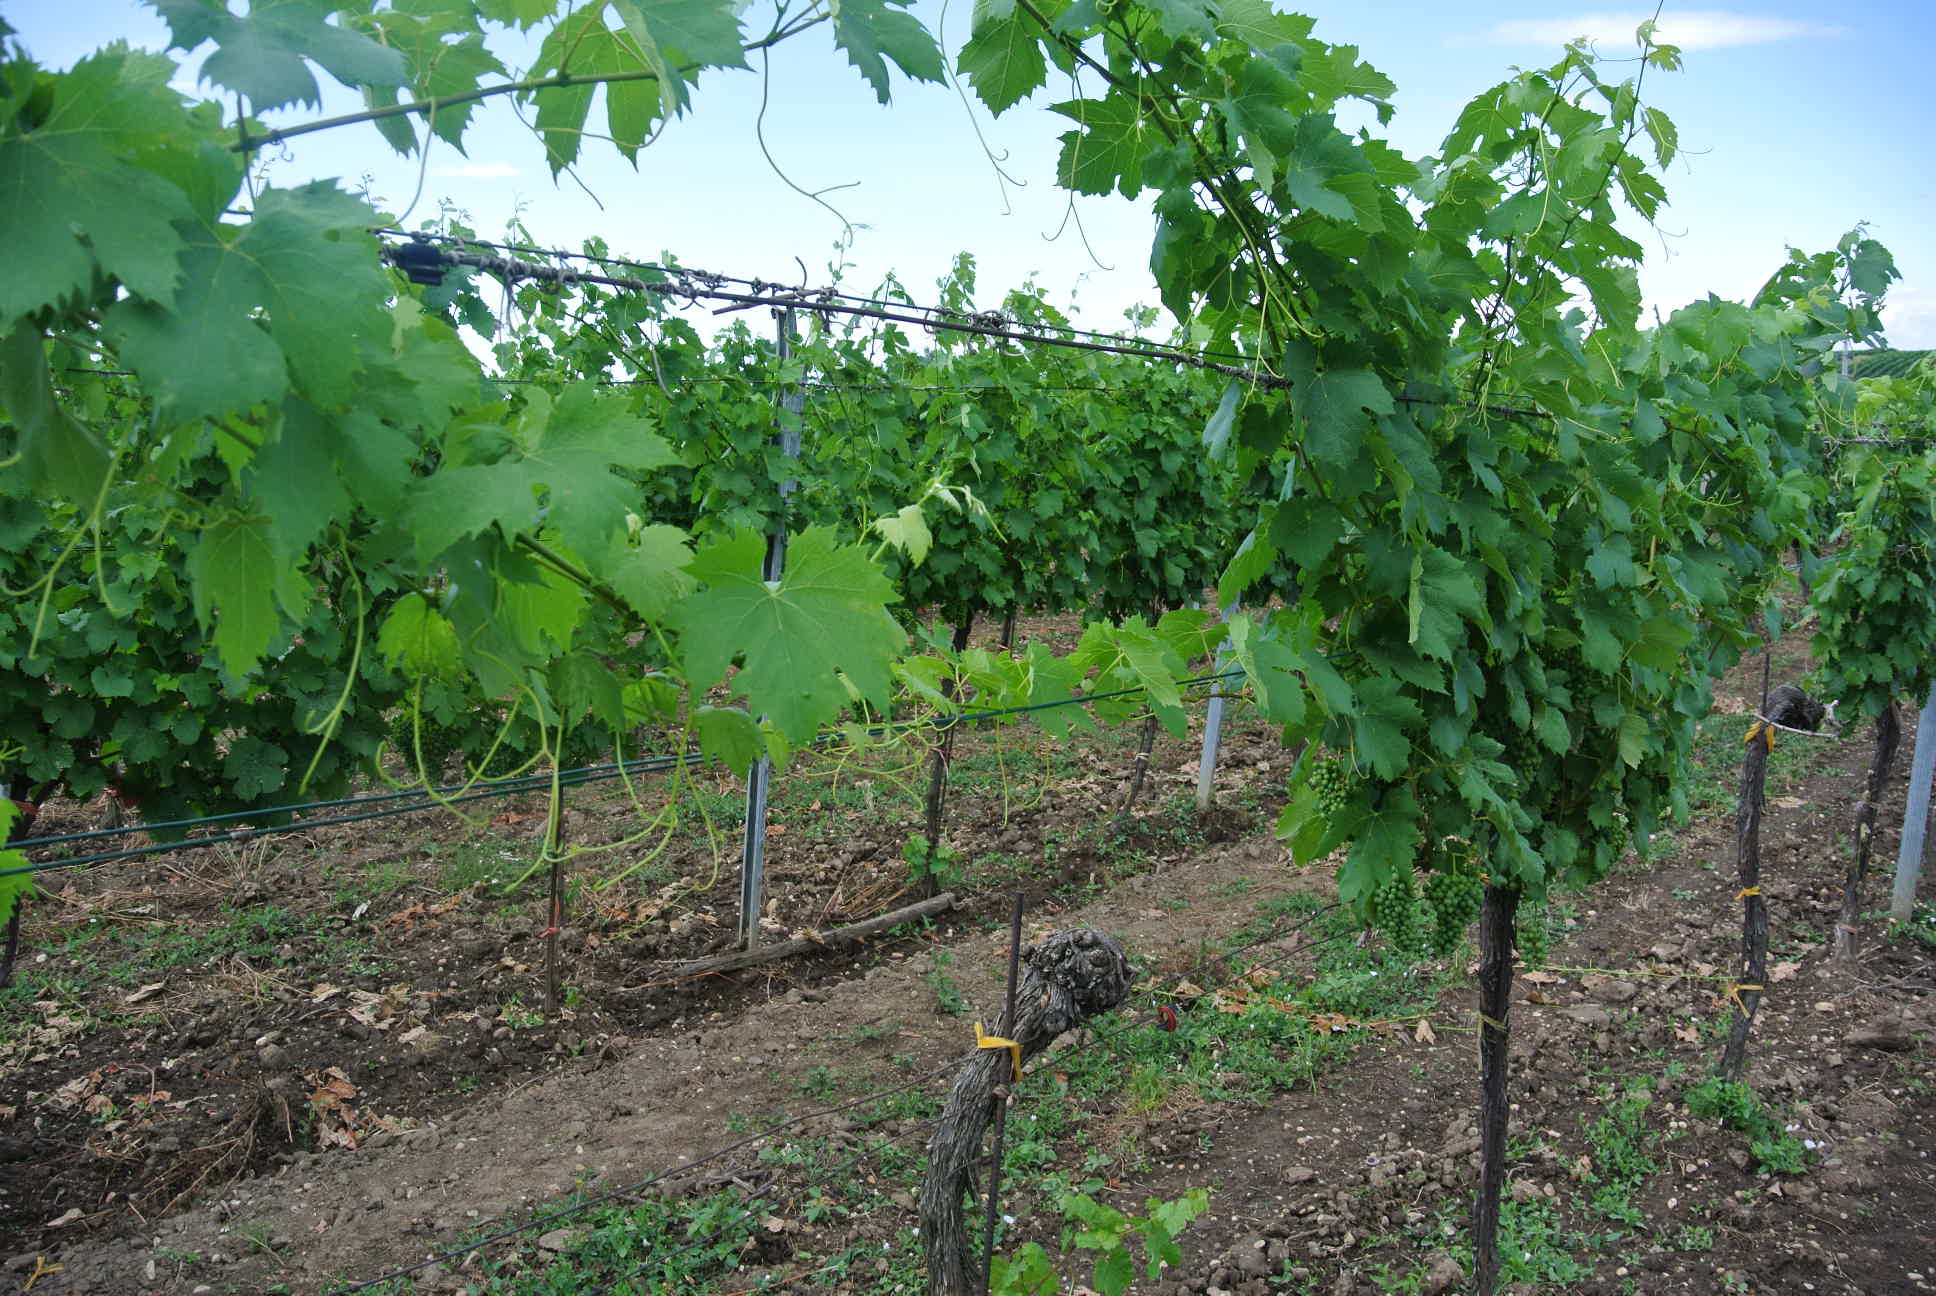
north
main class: Cropland
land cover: Vineyards
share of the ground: 25 - 50 %
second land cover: Other bare soil
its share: > 75 %
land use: Agriculture (excluding fallow land and kitchen gardens)
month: July
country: AT
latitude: 47.8975
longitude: 16.9220
